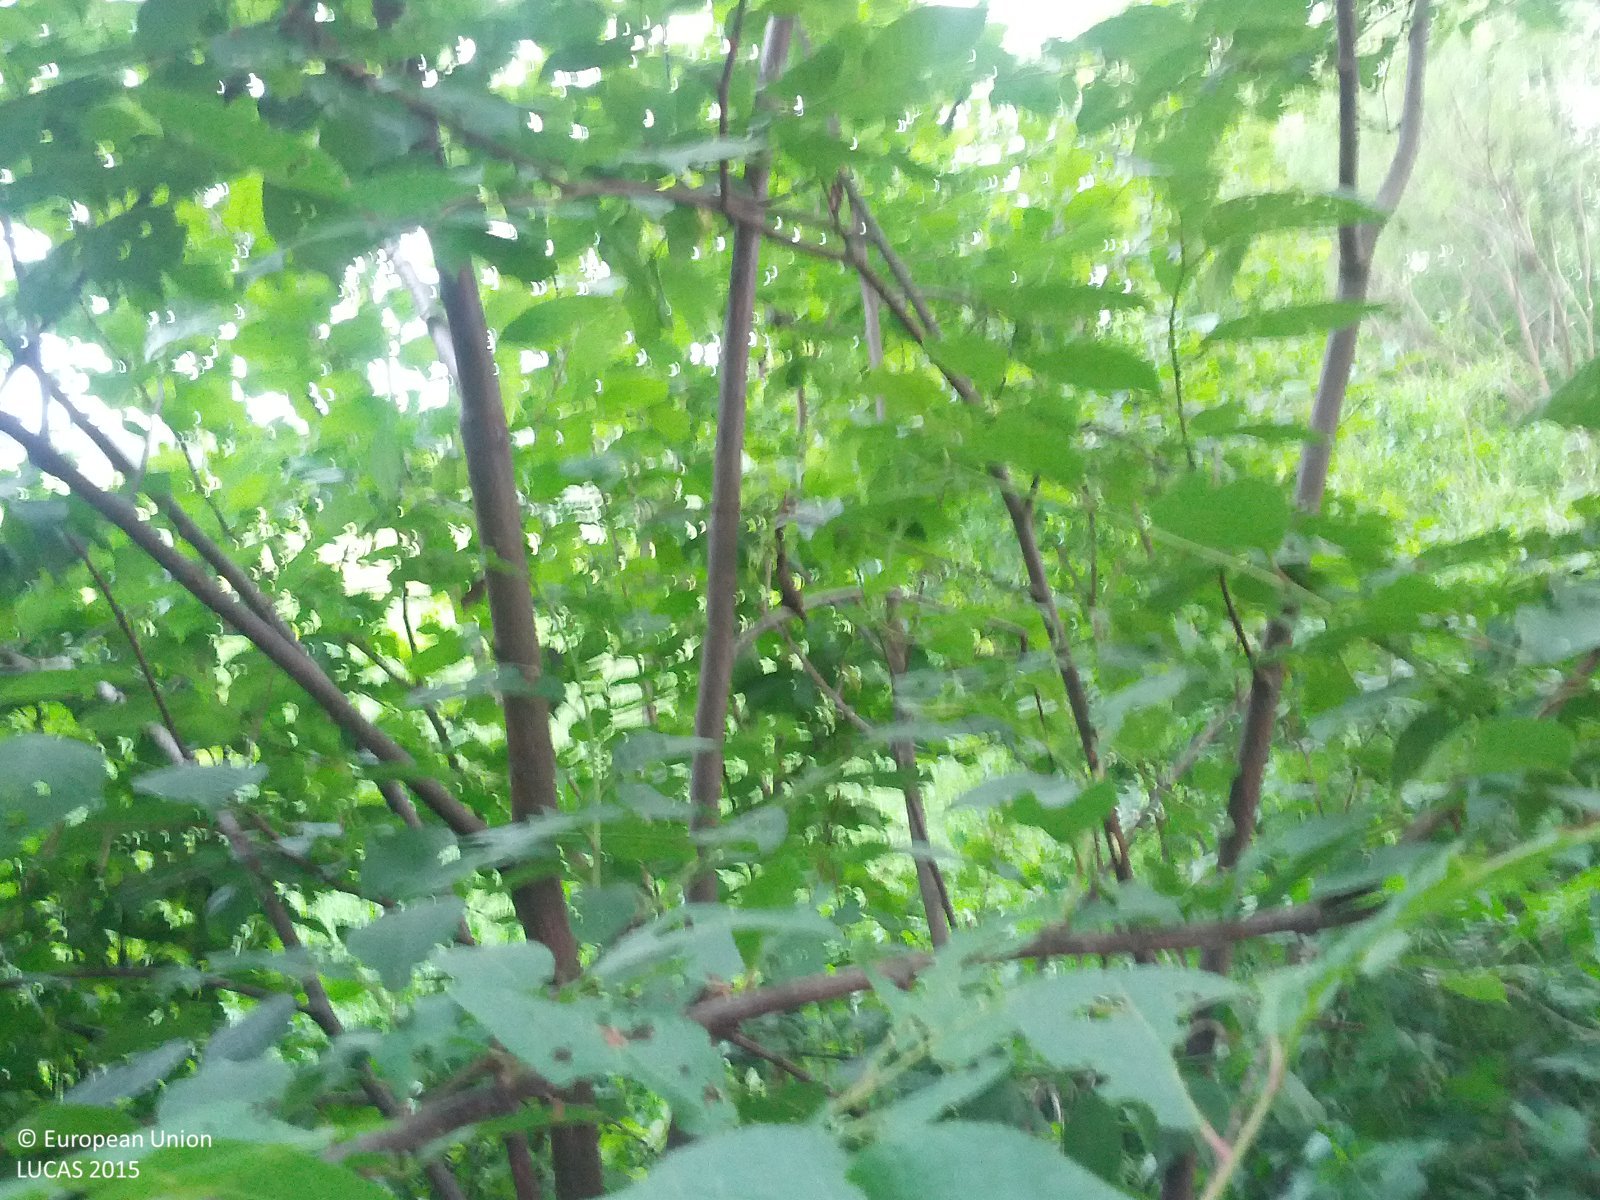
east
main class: Woodland
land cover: Broadleaved woodland
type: floodplain forest
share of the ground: > 75 %
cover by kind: broadleaved forest trees 40 %, shrubs 40 %, herbaceous plants 20 %
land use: Semi-natural and natural areas not in use
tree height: > 5 m
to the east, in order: Broadleaved woodland; Grassland without tree/shrub cover; Abandoned hedges; Tracks; Spruce dominated mixed woodland; Broadleaved woodland; Grass margins; Barley; Tracks; Broadleaved woodland
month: May
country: AT
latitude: 47.3325
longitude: 16.1027
